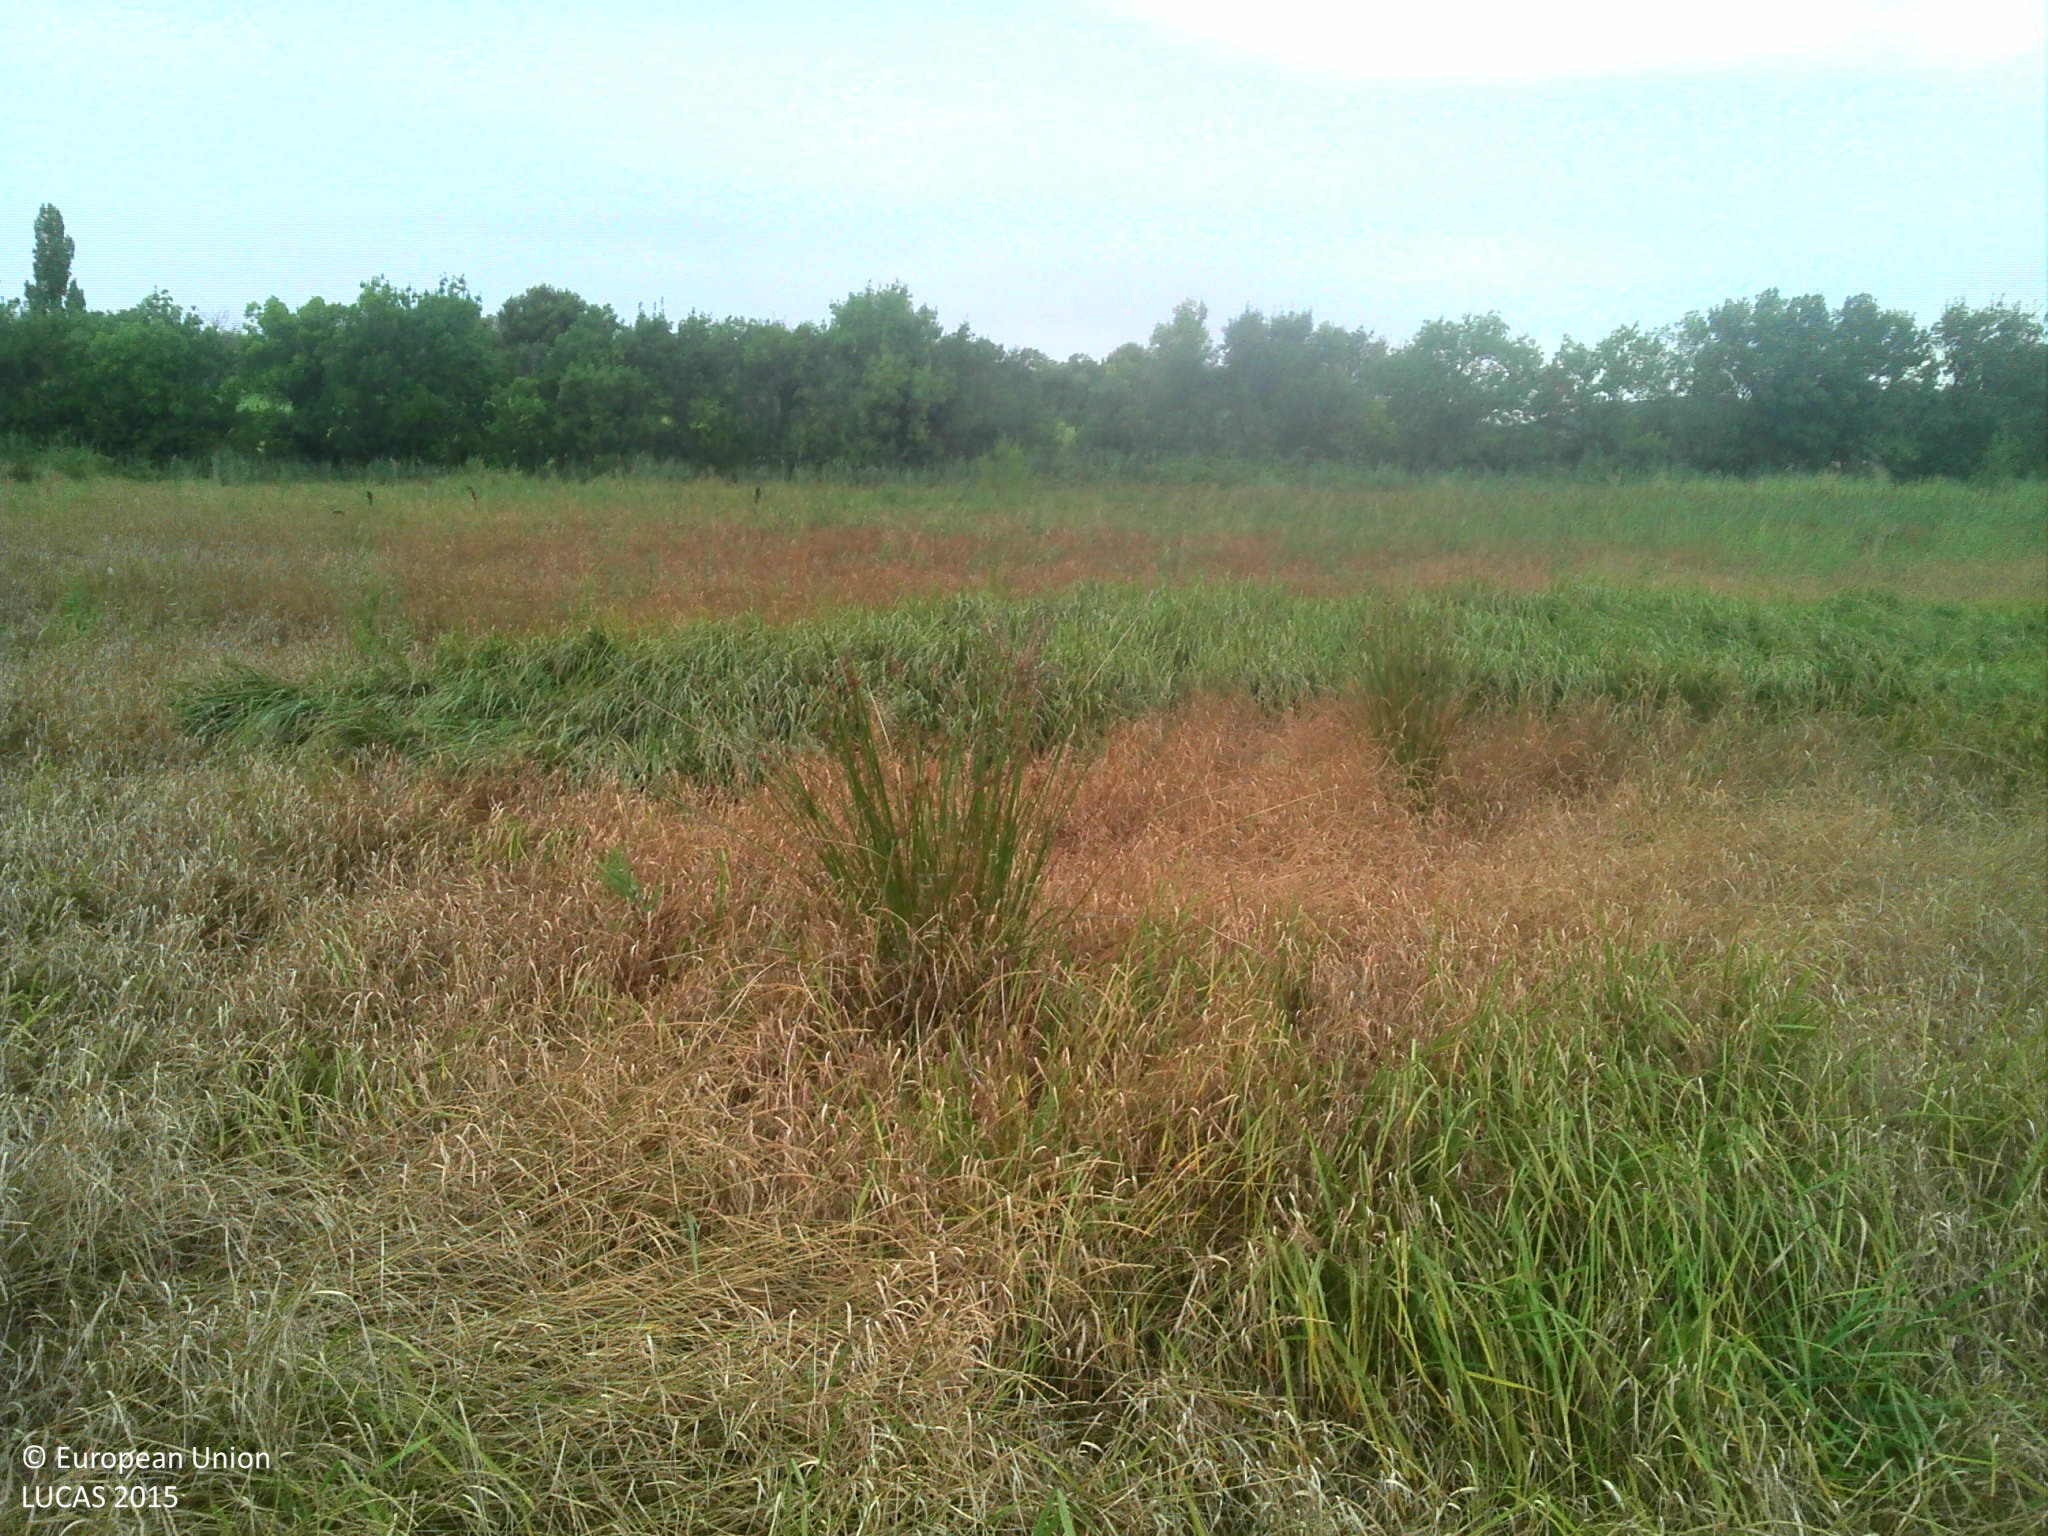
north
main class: Grassland
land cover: Grassland without tree/shrub cover
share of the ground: > 75 %
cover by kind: herbaceous plants 95 %, shrubs 5 %
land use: Semi-natural and natural areas not in use
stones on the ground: < 10 %
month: July
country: FR
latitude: 43.5275
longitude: 5.0483
